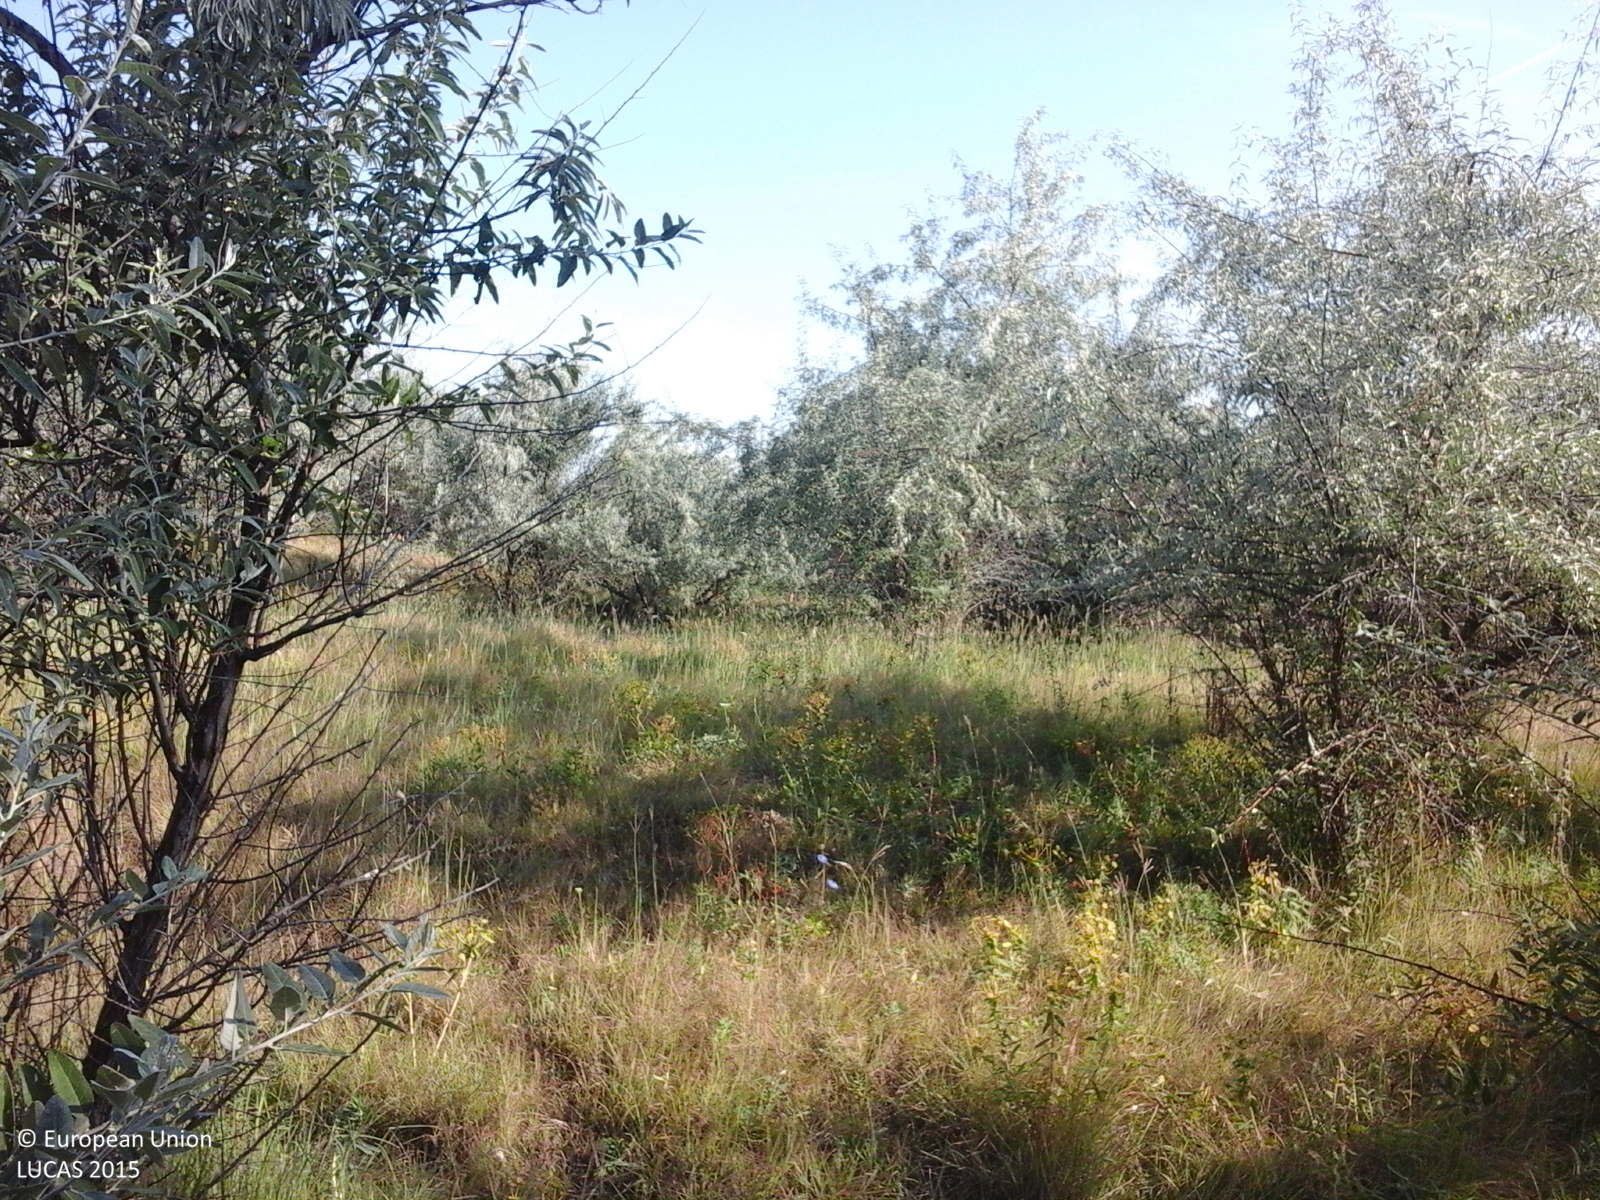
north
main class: Shrubland
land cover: Shrubland without tree cover
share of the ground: > 75 %
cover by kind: shrubs 70 %, herbaceous plants 30 %
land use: Agriculture (excluding fallow land and kitchen gardens)
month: July
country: RO
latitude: 46.5313
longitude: 28.1632
